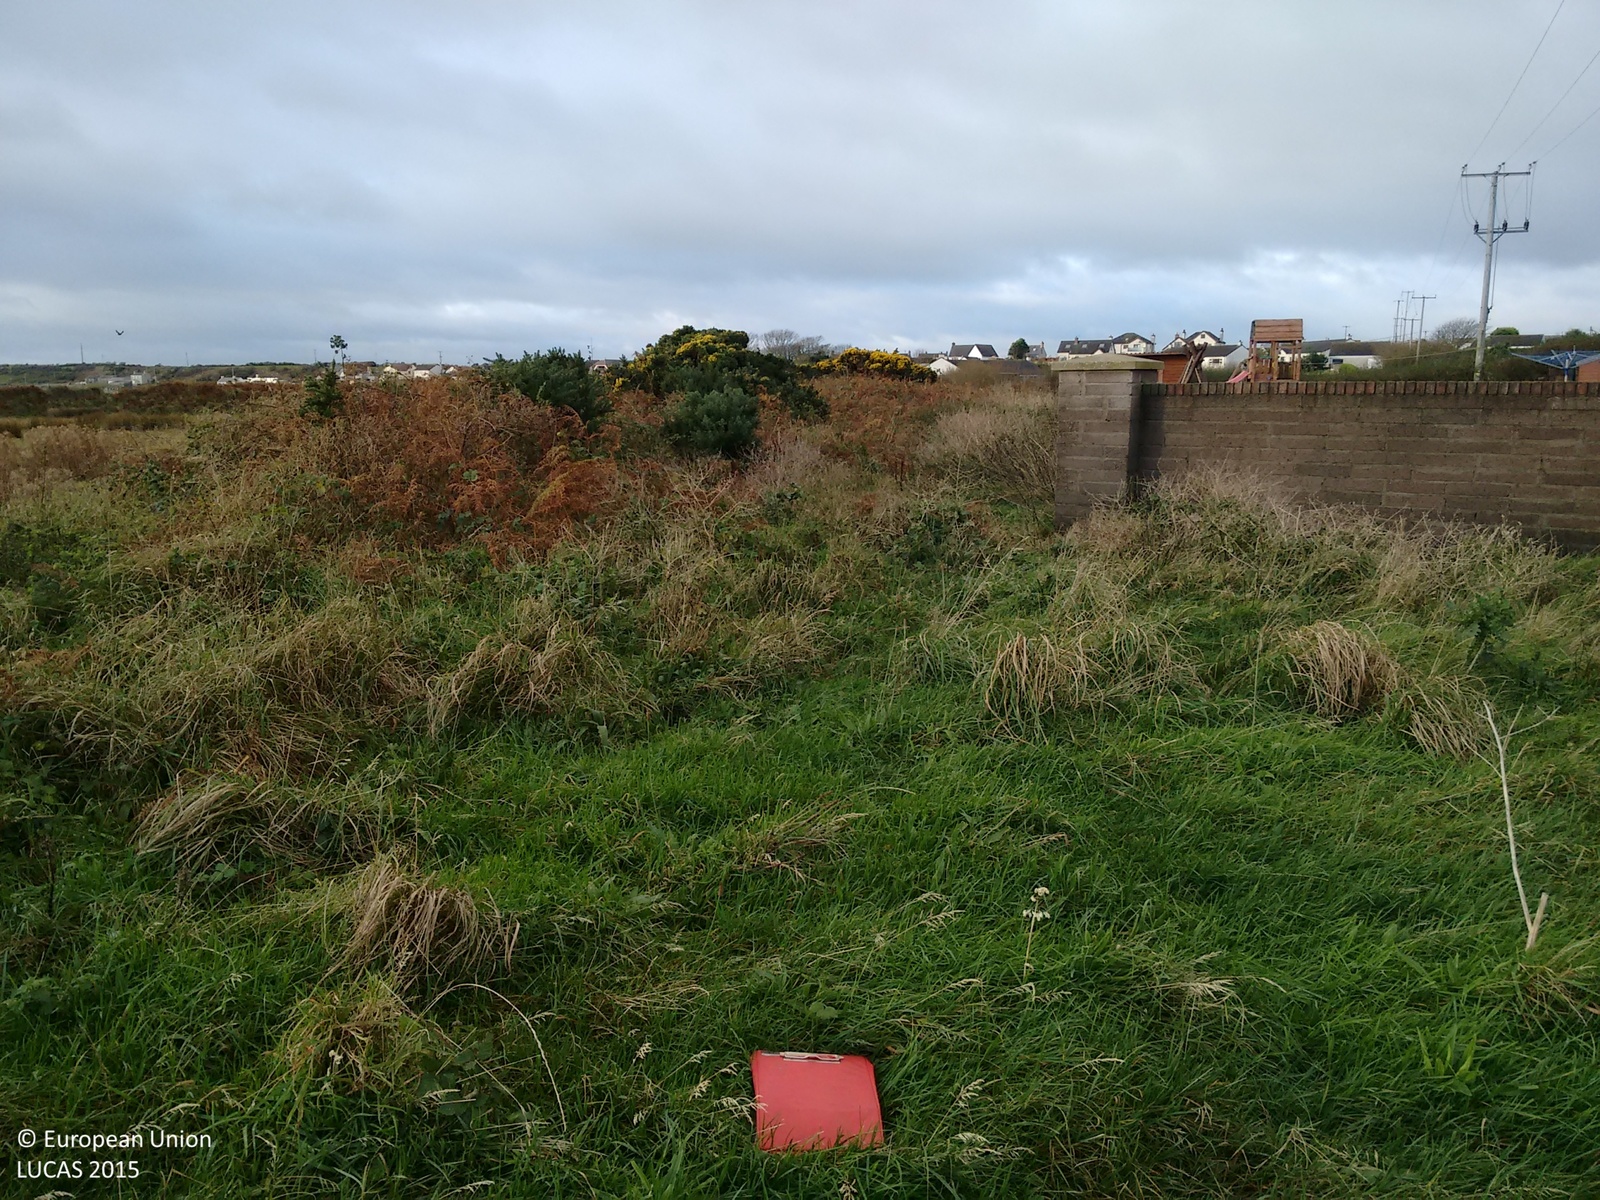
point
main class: Grassland
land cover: Grassland without tree/shrub cover
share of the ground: > 75 %
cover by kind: herbaceous plants 100 %
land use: Agriculture (excluding fallow land and kitchen gardens)
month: November
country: GB
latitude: 54.4558
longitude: -5.4428
